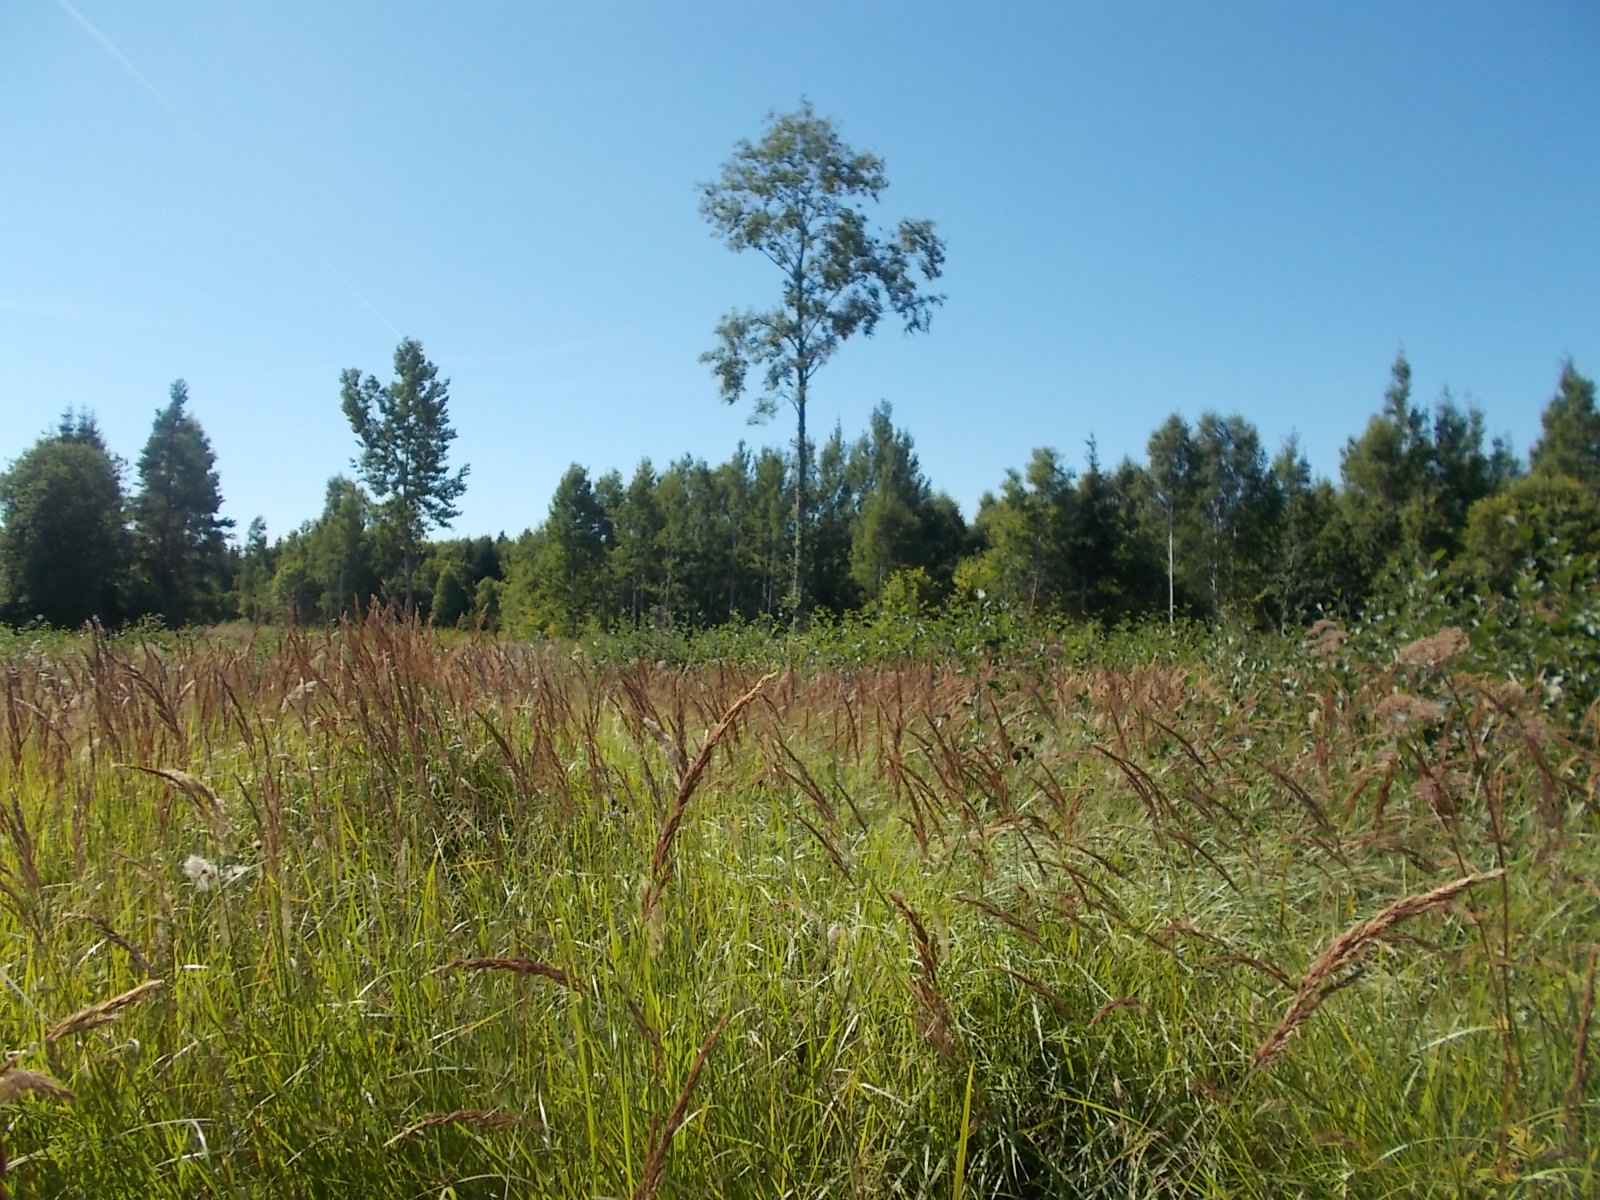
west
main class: Grassland
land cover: Spontaneously vegetated surfaces
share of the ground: > 75 %
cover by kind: herbaceous plants 95 %, shrubs 5 %
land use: Semi-natural and natural areas not in use
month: August
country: LV
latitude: 56.8815
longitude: 22.9121
